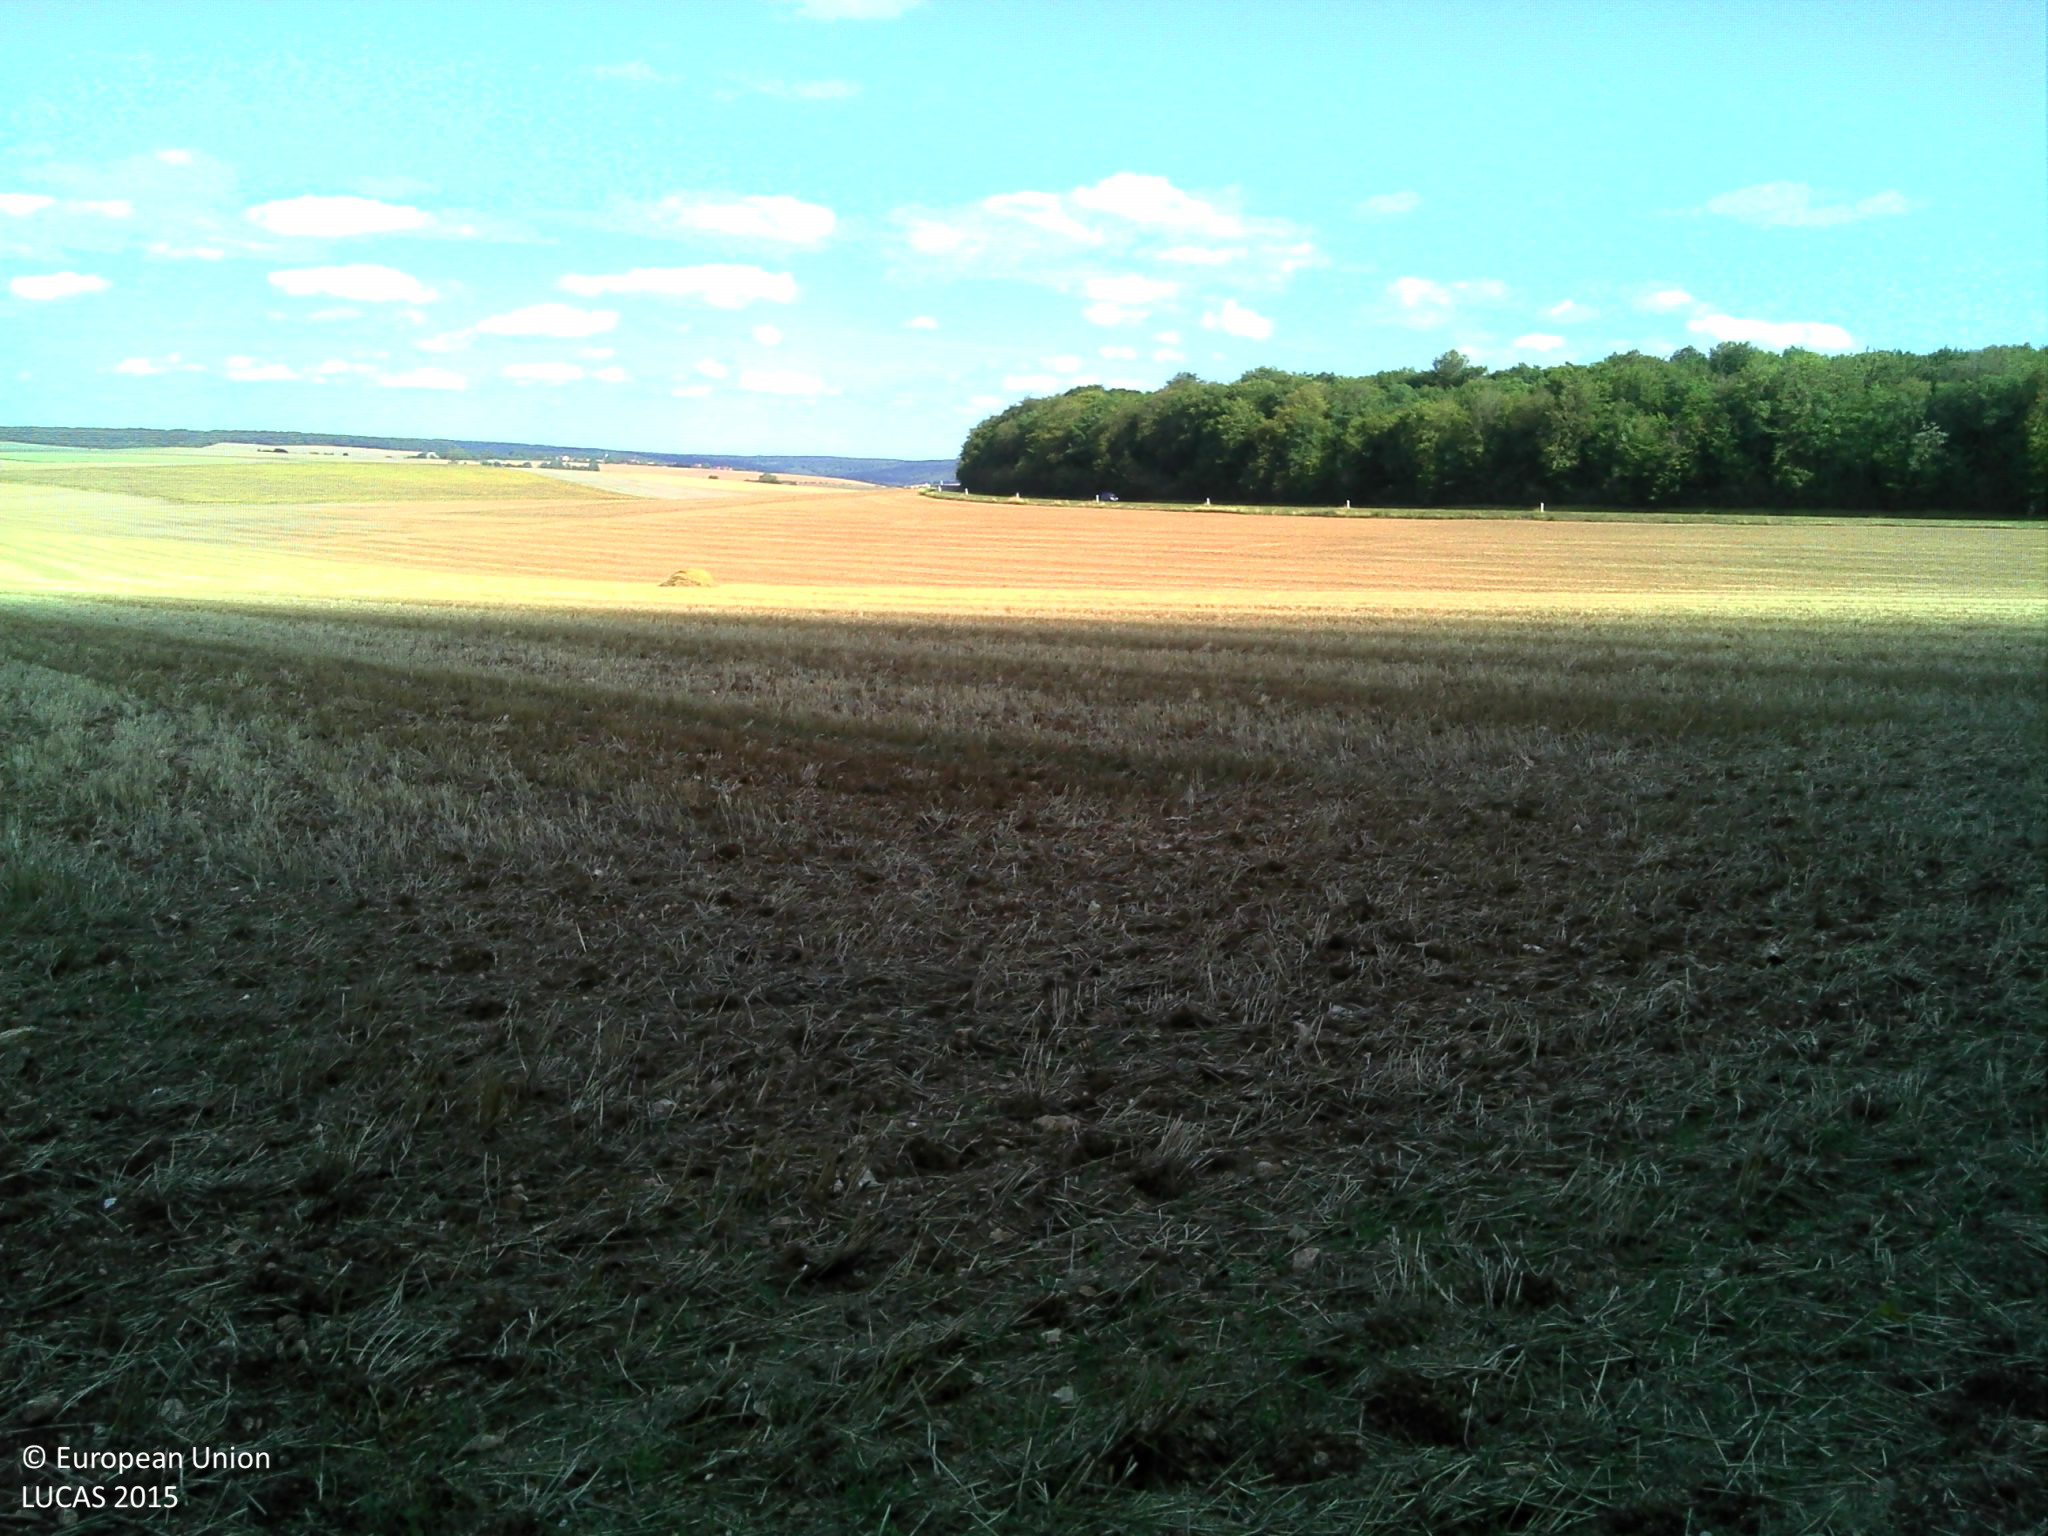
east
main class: Cropland
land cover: Common wheat
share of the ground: > 75 %
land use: Agriculture (excluding fallow land and kitchen gardens)
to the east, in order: Common wheat
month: August
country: FR
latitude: 47.7816
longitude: 4.9144
